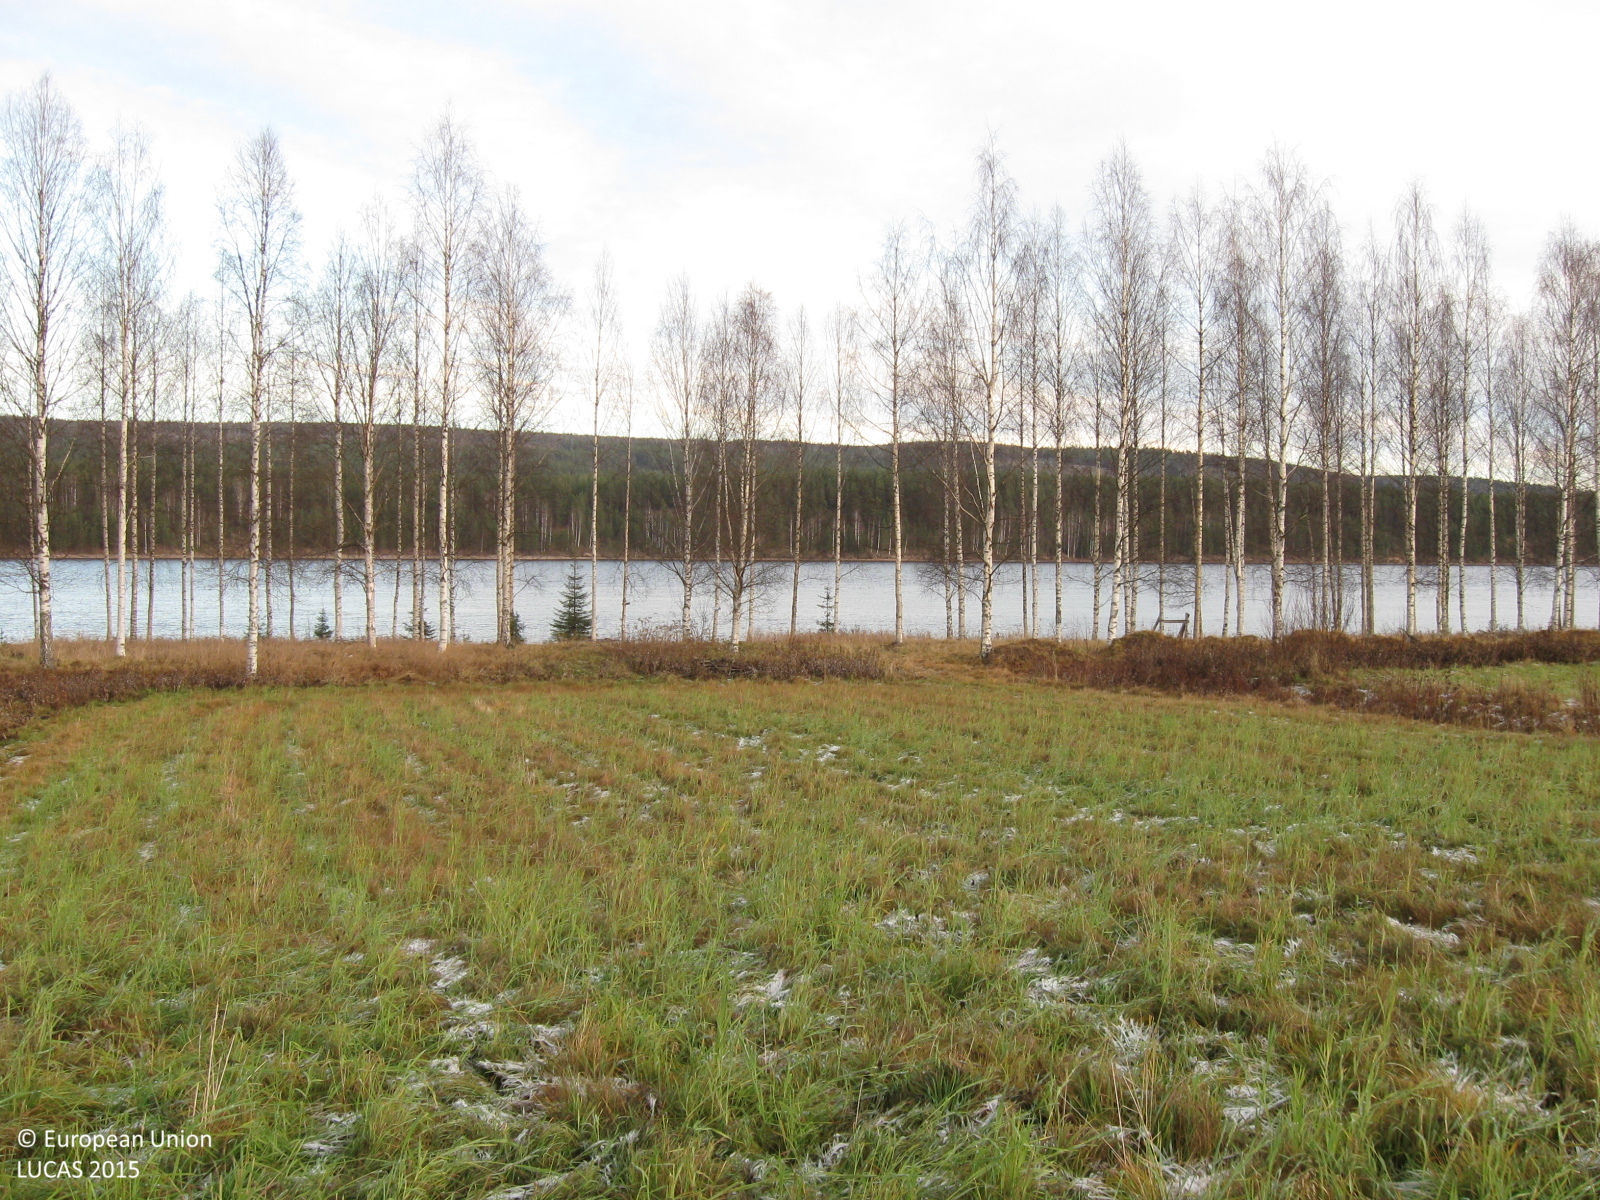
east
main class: Grassland
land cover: Grassland without tree/shrub cover
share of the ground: > 75 %
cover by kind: herbaceous plants 100 %
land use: Agriculture (excluding fallow land and kitchen gardens)
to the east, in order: Grassland without tree/shrub cover; Shruby margins; Ditches and canals; Broadleaved woodland; Inland fresh running water
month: October
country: SE
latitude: 66.2944
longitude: 20.8157
